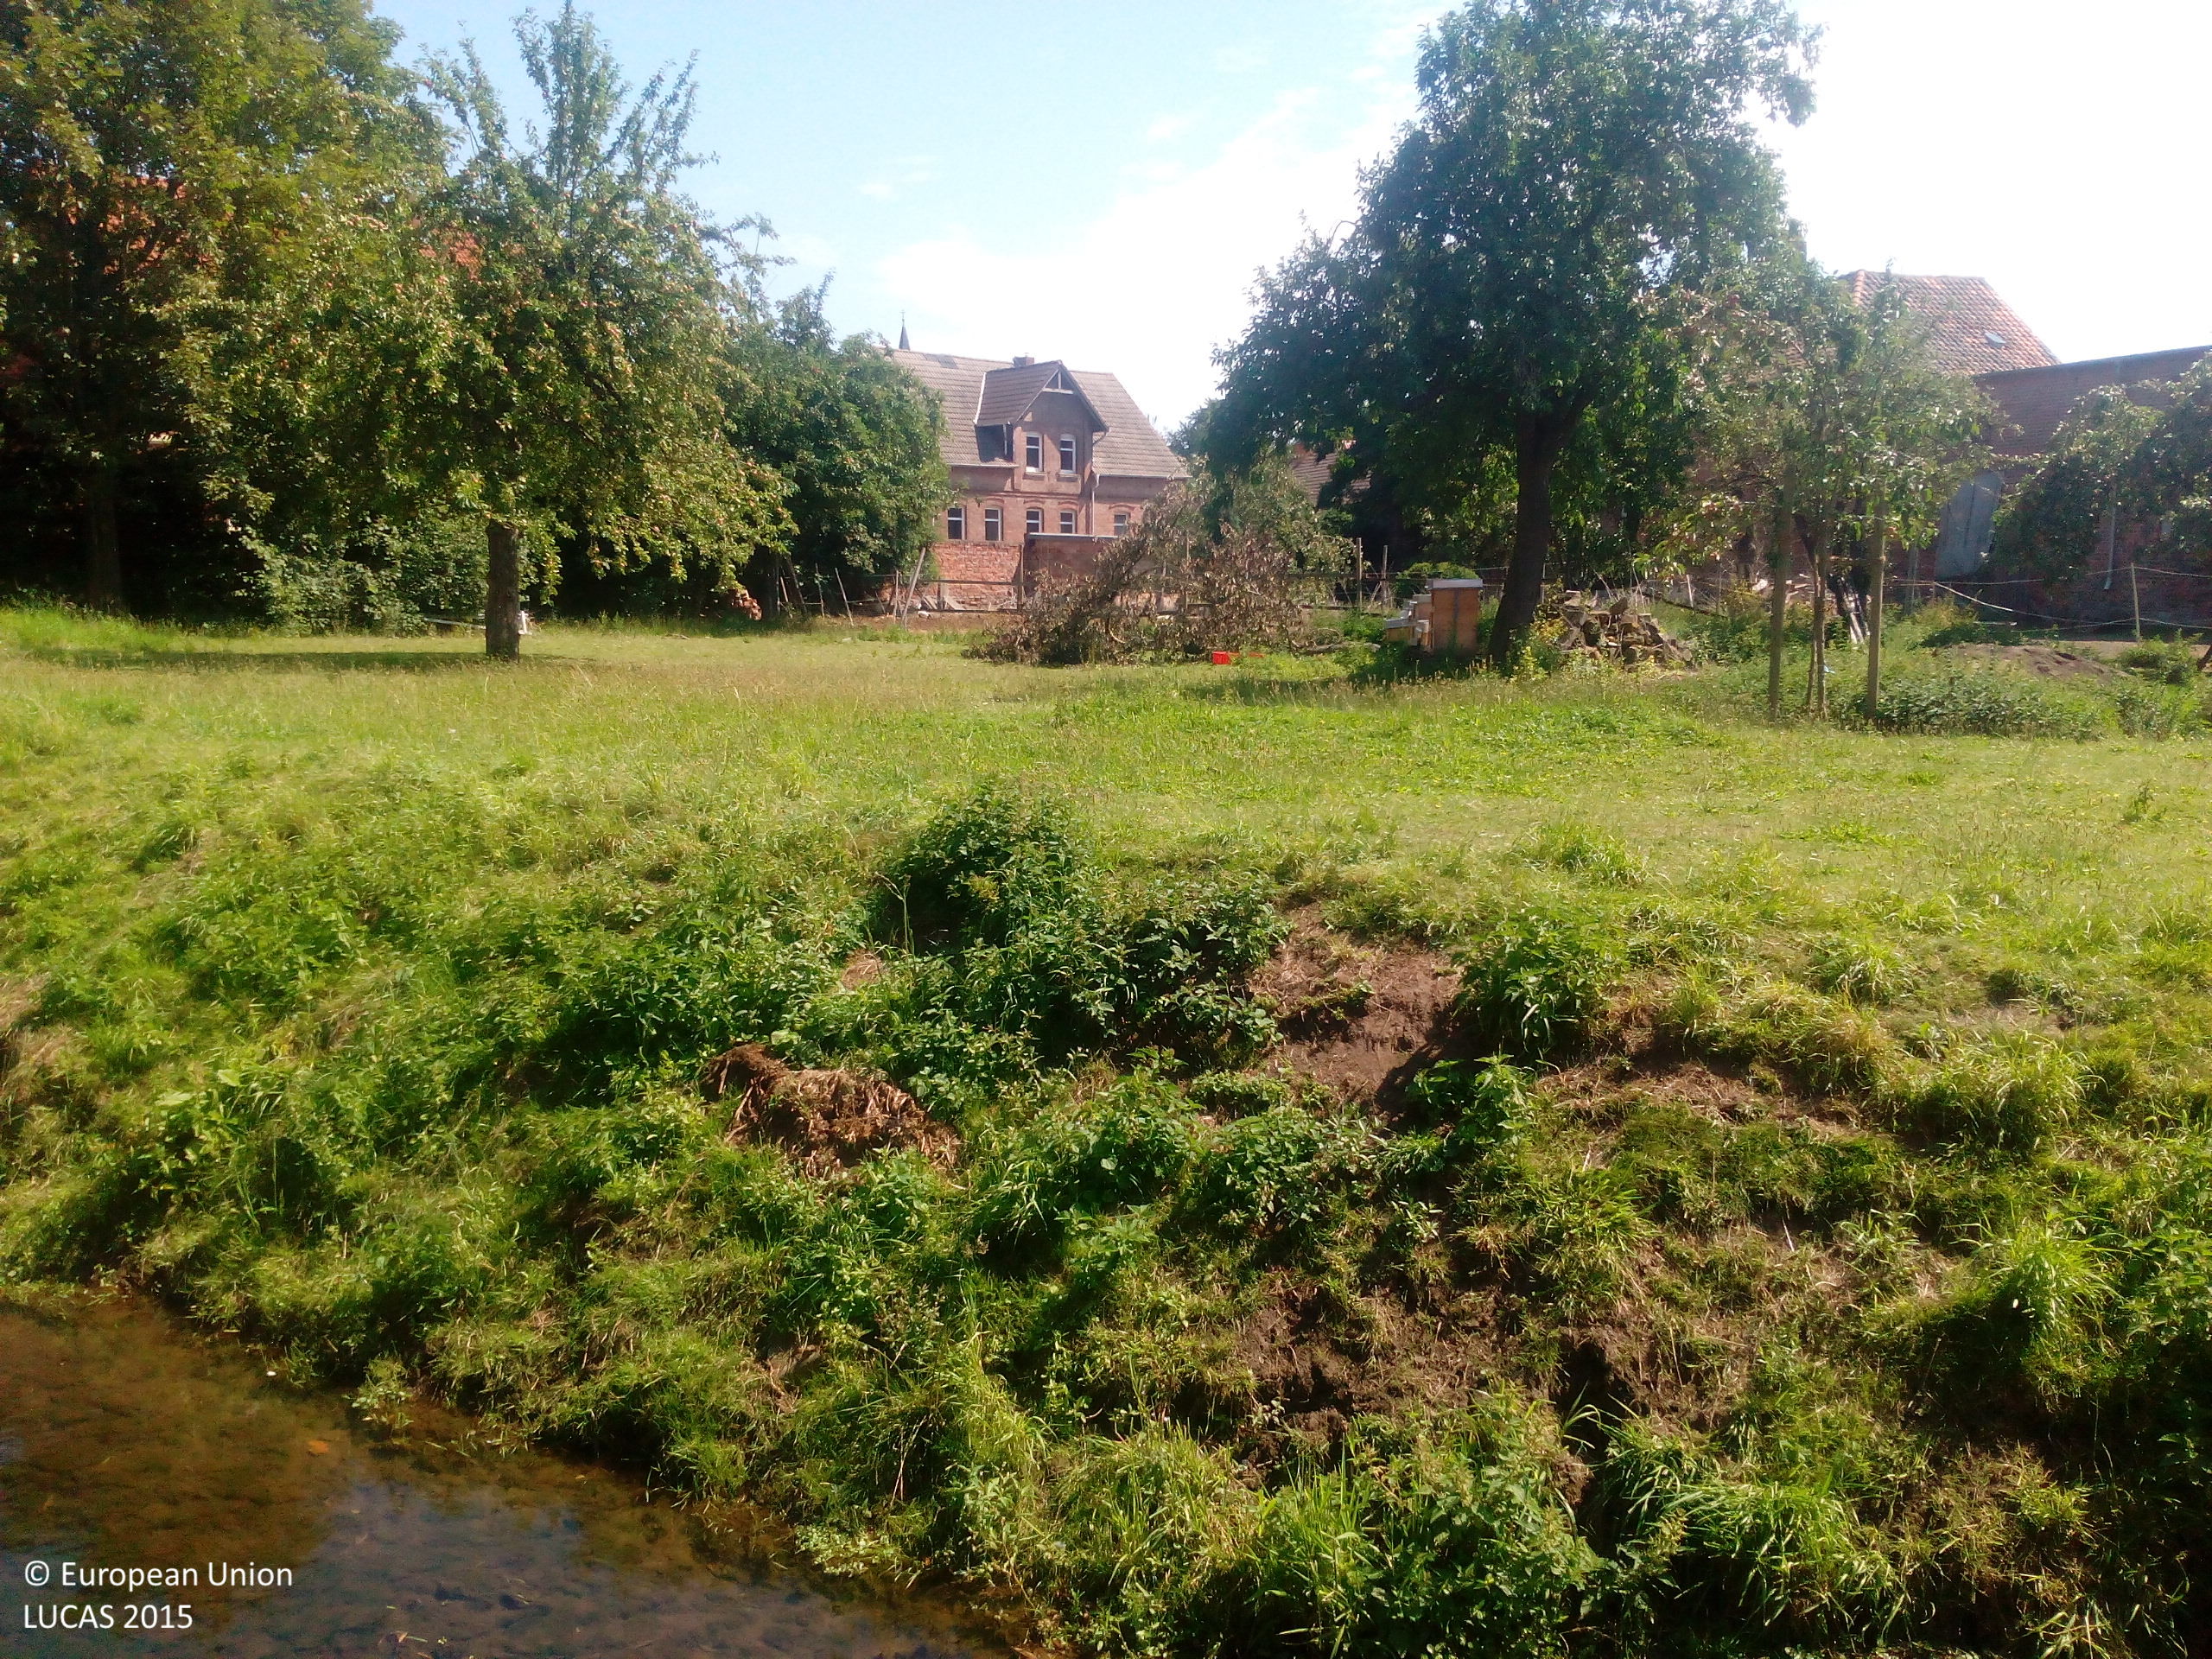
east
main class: Grassland
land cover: Grassland with sparse tree/shrub cover
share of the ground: > 75 %
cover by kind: herbaceous plants 95 %, broadleaved forest trees 5 %
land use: Residential
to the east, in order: Grassland with sparse tree/shrub cover; Artificial constructions in urban areas; Broadleaved woodland; Grassland without tree/shrub cover; Other root crops
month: August
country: DE
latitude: 52.0845
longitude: 11.1233
